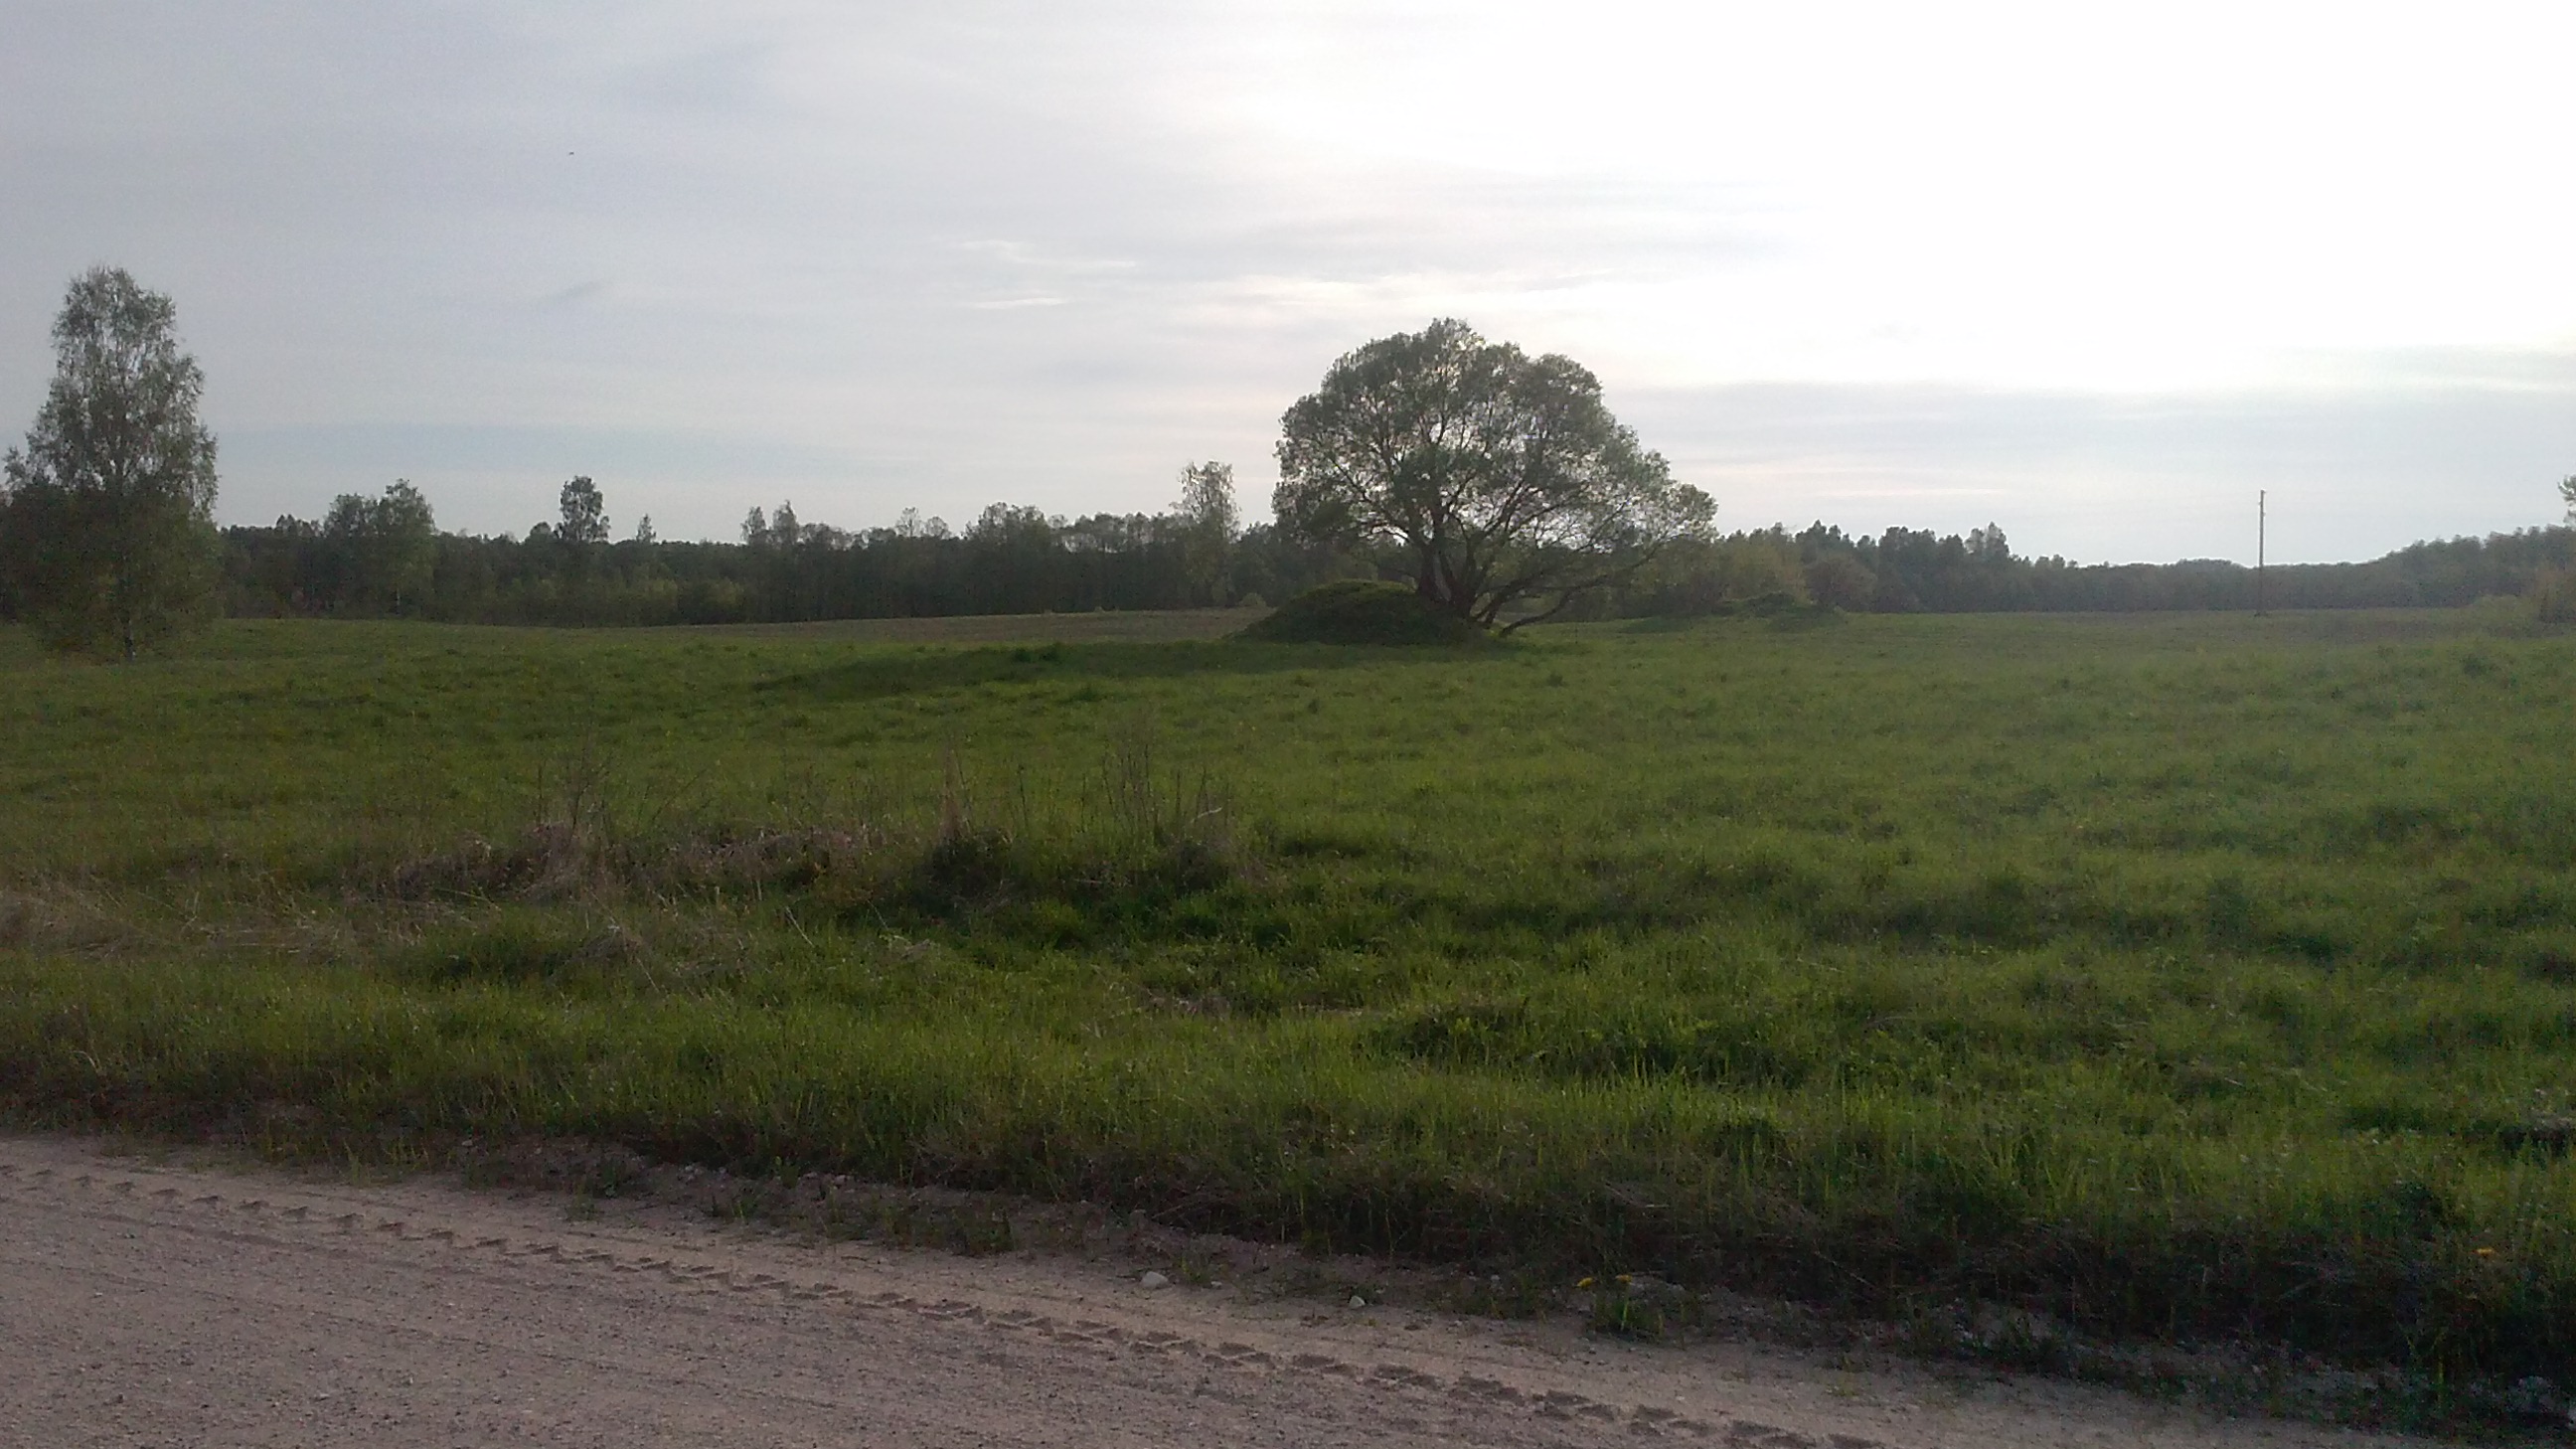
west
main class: Woodland
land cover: Broadleaved woodland
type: non-riverine alder, birch or aspen forest
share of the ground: > 75 %
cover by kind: broadleaved forest trees 100 %
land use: Forestry
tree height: > 5 m
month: May
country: LV
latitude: 56.0013
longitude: 27.7819
